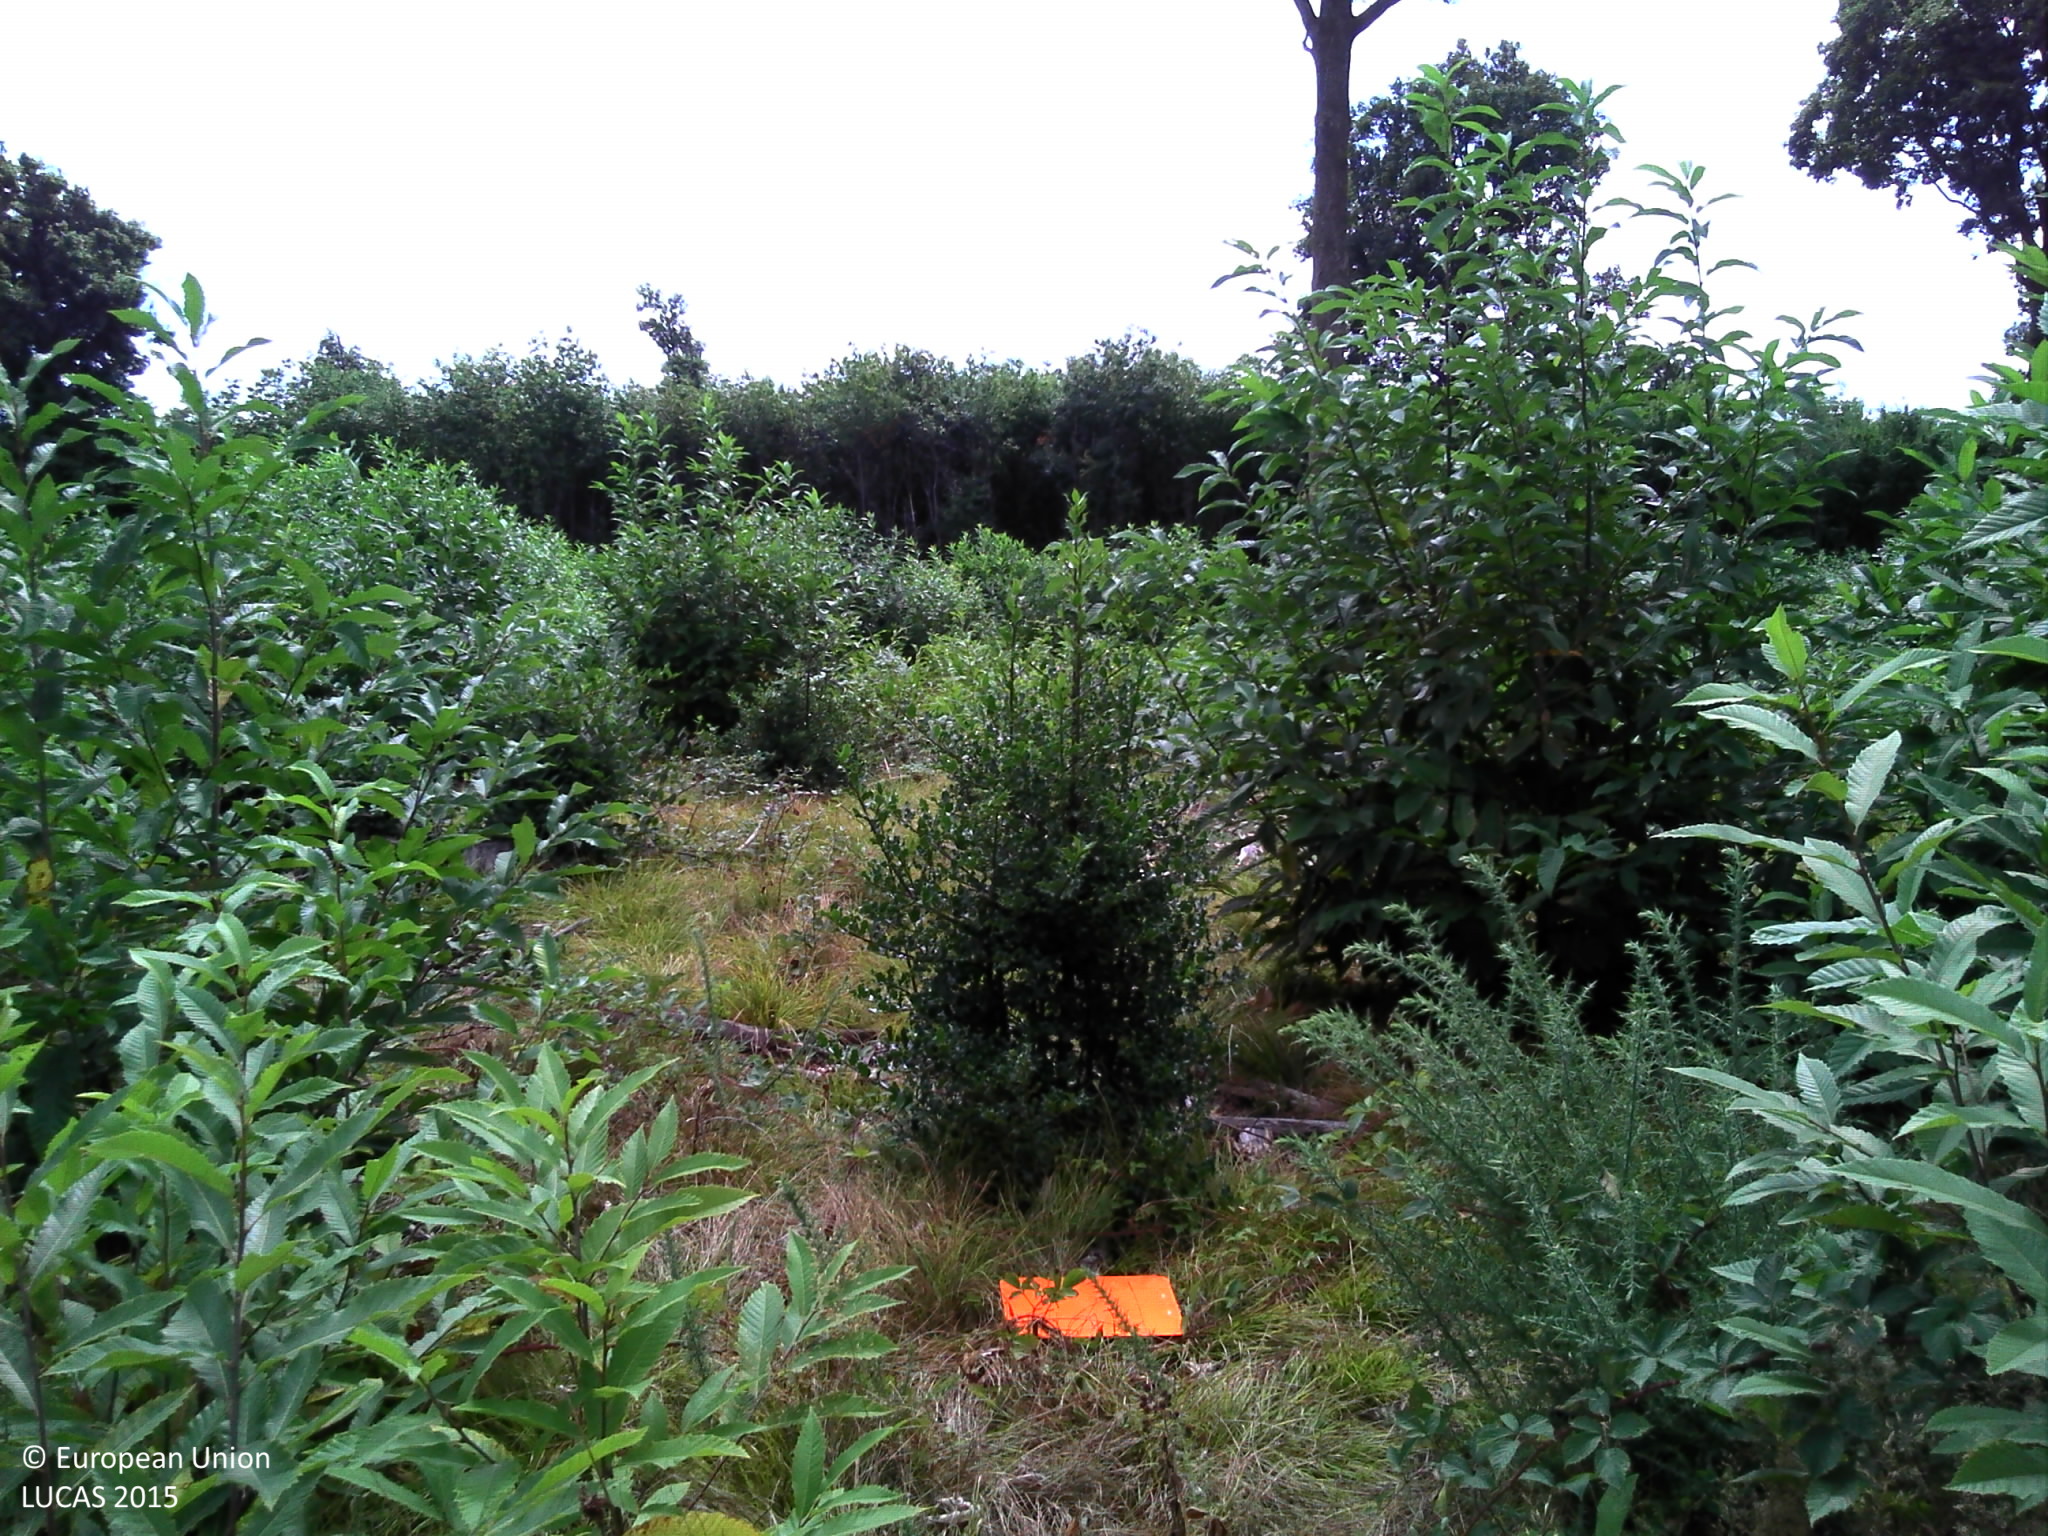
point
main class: Woodland
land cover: Broadleaved woodland
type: acidophilous oak and oak-birch forest
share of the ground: > 75 %
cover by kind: broadleaved forest trees 85 %, herbaceous plants 10 %, shrubs 5 %
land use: Forestry
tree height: < 5 m
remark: Clear cut
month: August
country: FR
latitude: 46.1283
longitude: 0.3147
